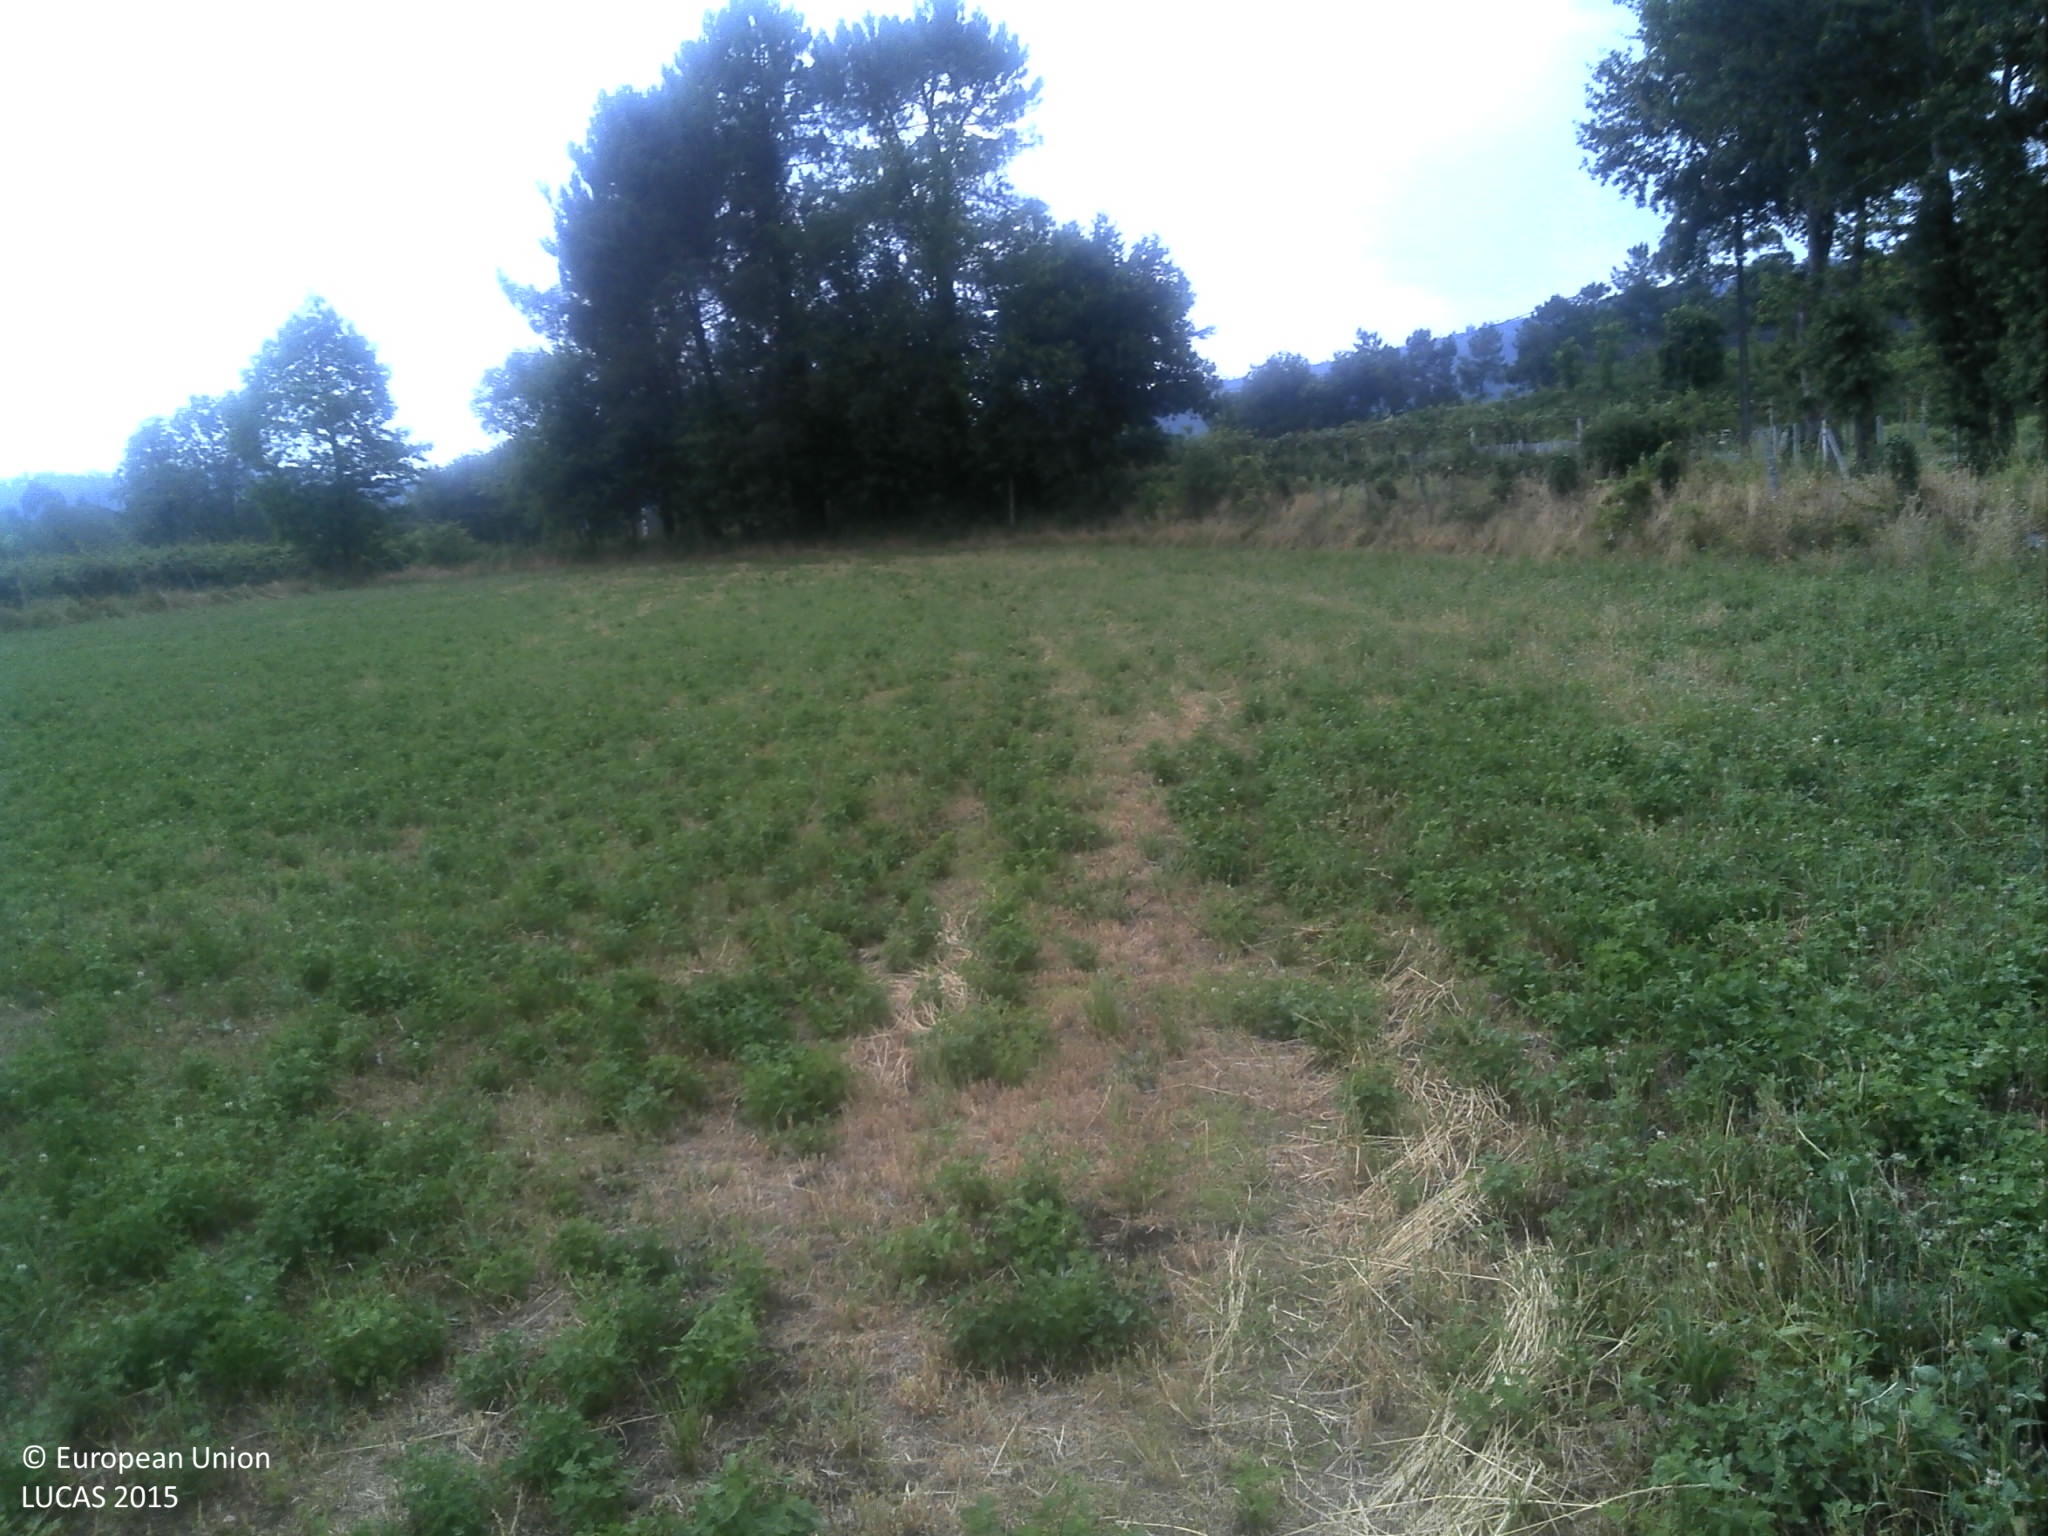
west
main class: Grassland
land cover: Grassland without tree/shrub cover
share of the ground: > 75 %
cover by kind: herbaceous plants 75 %, unconsolidated bare surface 25 %
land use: Semi-natural and natural areas not in use
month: June
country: PT
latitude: 41.6891
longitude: -8.4055
